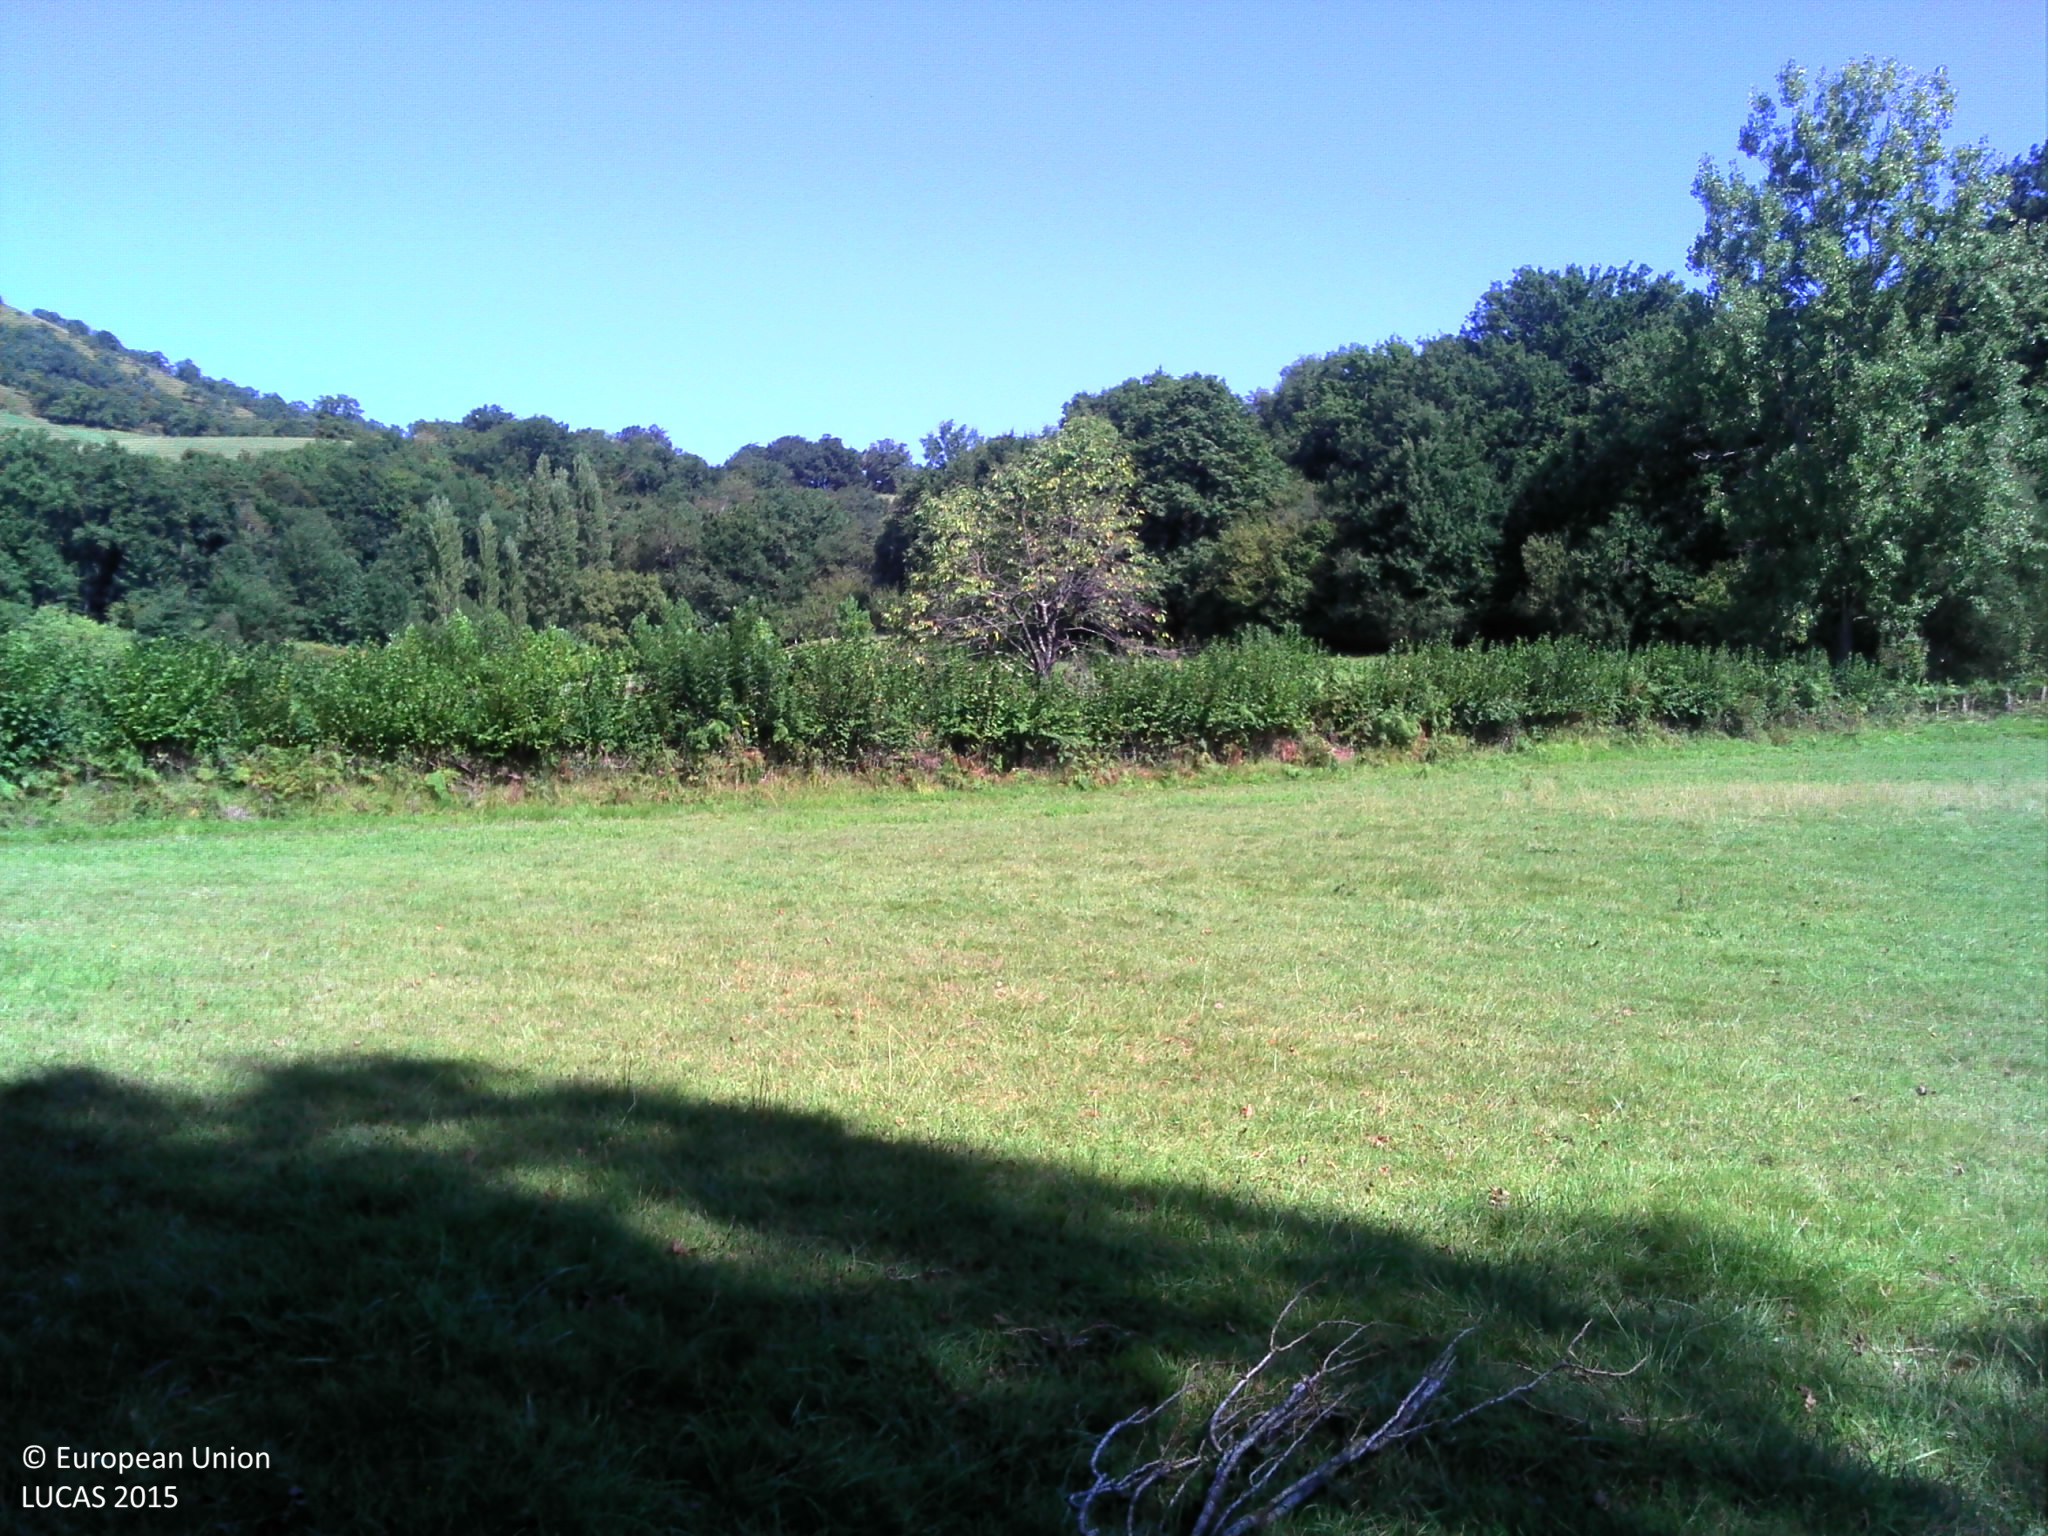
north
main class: Grassland
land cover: Grassland without tree/shrub cover
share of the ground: > 75 %
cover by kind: herbaceous plants 100 %
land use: Agriculture (excluding fallow land and kitchen gardens)
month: September
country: FR
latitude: 43.2453
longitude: -1.0845
